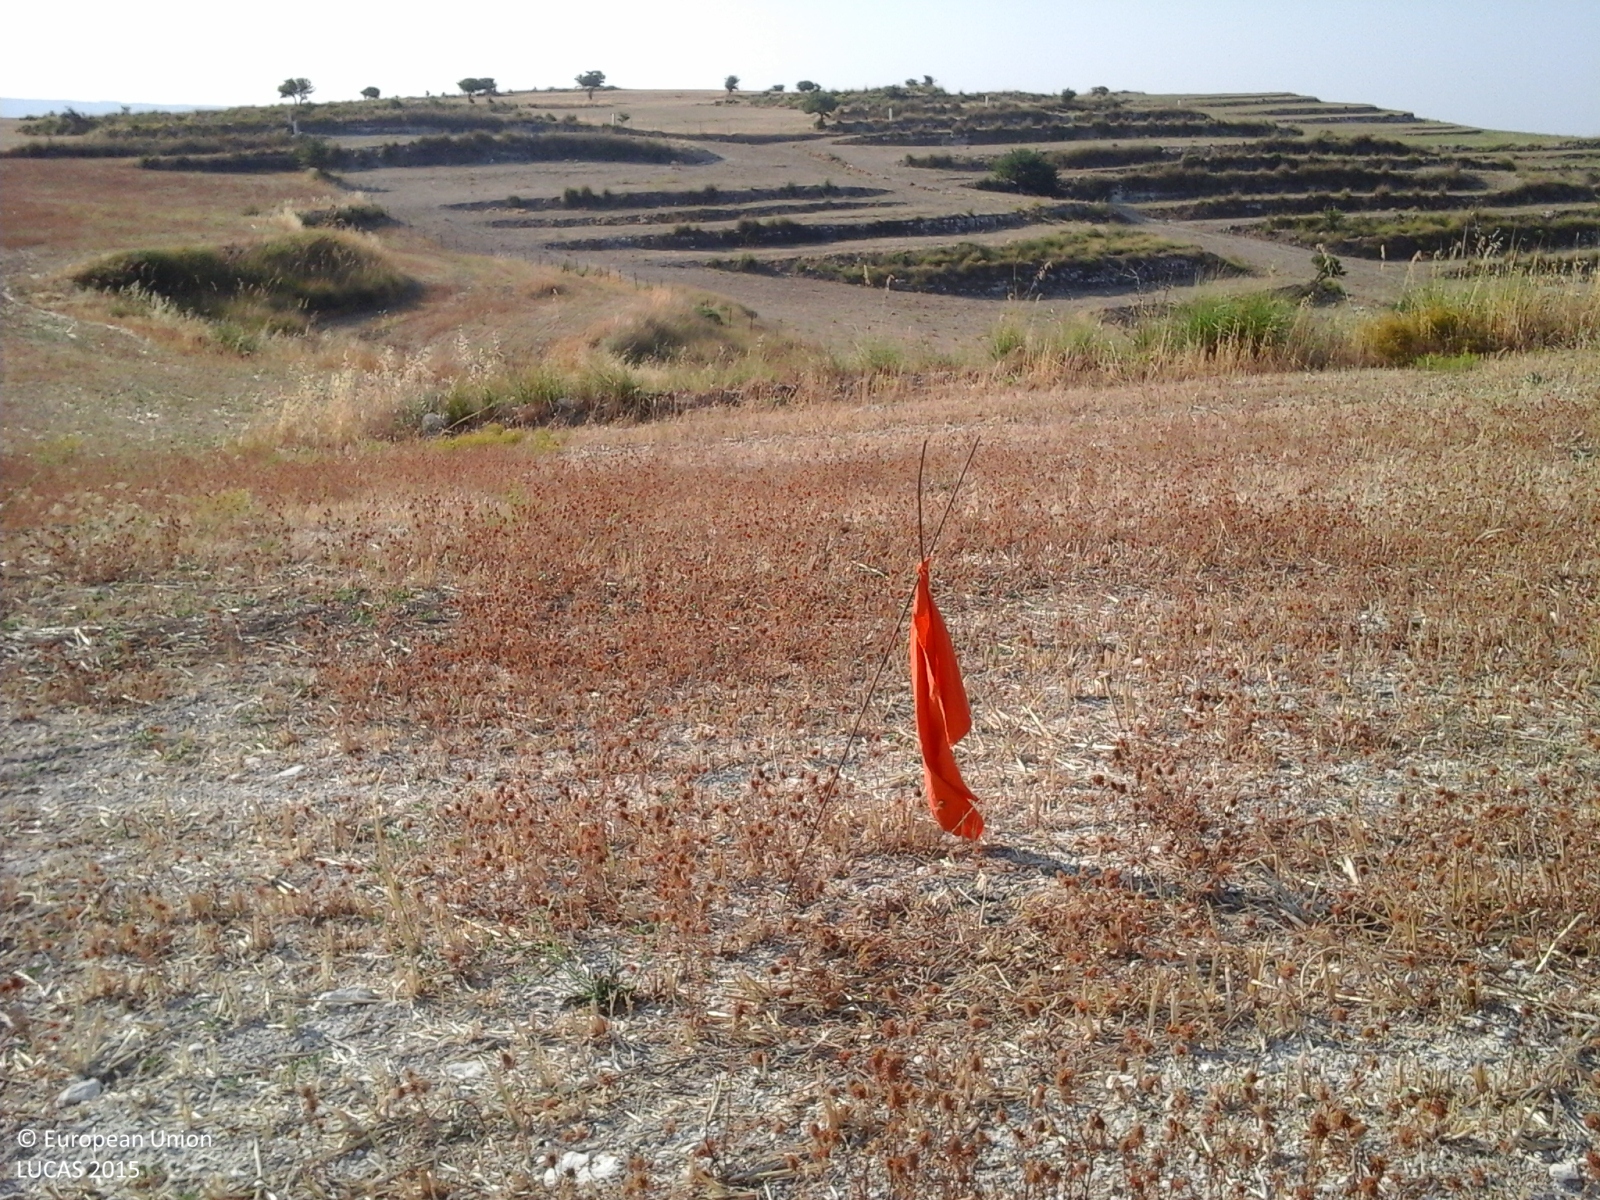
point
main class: Cropland
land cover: Mixed cereals for fodder
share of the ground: > 75 %
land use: Agriculture (excluding fallow land and kitchen gardens)
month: July
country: IT
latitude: 37.0427
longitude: 14.8308
